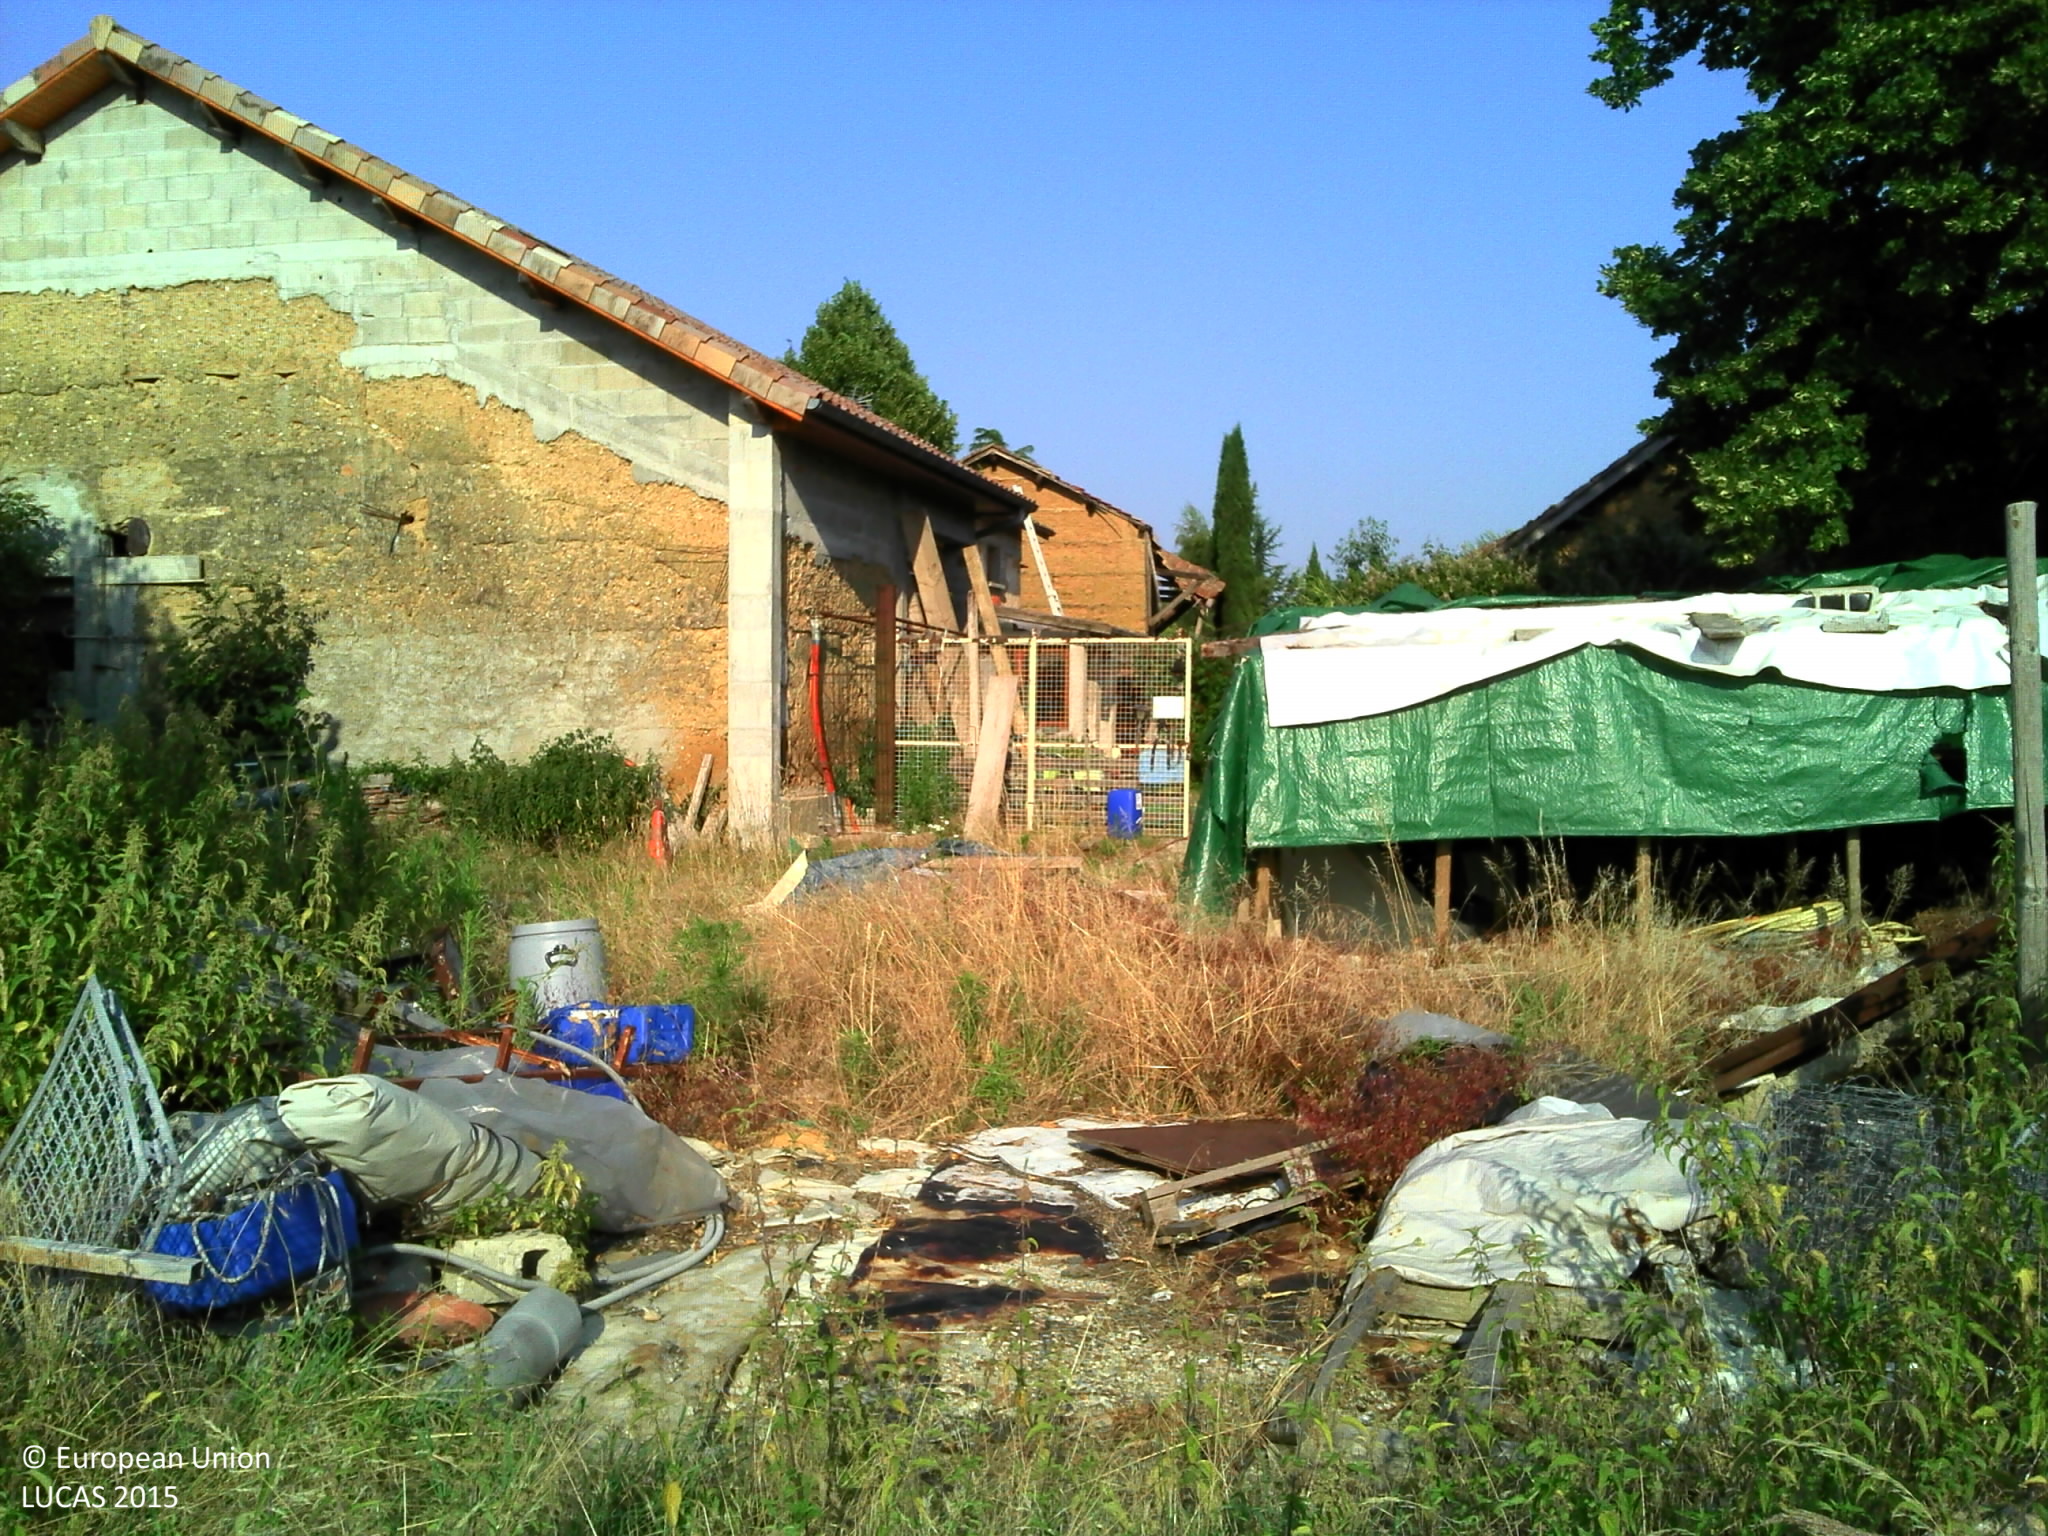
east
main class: Grassland
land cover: Grassland with sparse tree/shrub cover
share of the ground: > 75 %
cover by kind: herbaceous plants 70 %, consolidated bare surface 15 %, shrubs 10 %, broadleaved forest trees 5 %
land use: Residential
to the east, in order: Grassland with sparse tree/shrub cover; Artificial constructions in urban areas; Single bushes/trees; Electric lines; Tracks; Grass margins; Maize; Common wheat; Maize
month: July
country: FR
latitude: 45.6005
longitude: 5.3505
